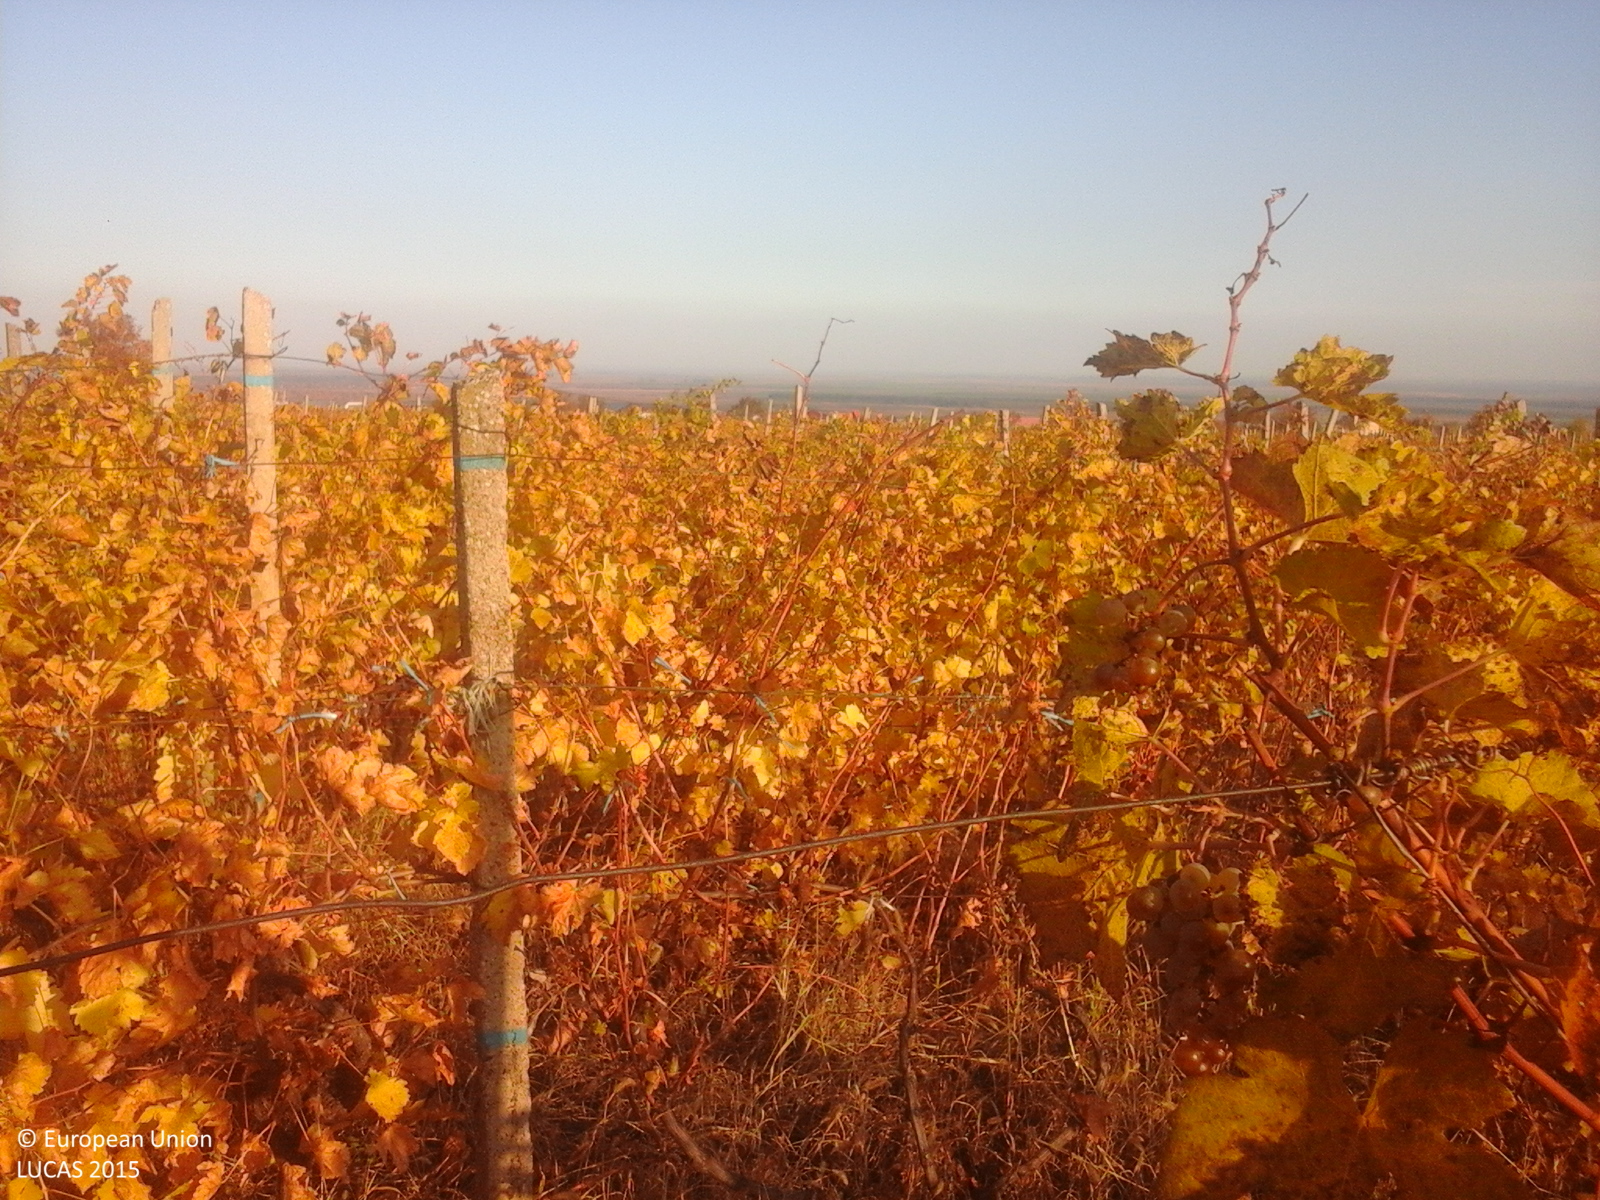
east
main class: Cropland
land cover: Vineyards
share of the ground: > 75 %
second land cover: Other bare soil
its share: > 75 %
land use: Agriculture (excluding fallow land and kitchen gardens)
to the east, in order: Vineyards; Other bare soil; Grass margins; Tracks; Grass margins; Vineyards; Grass margins; Tracks; Grass margins; Vineyards; Grass margins; Tracks; Grass margins; Vineyards
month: October
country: RO
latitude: 45.4857
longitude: 27.0415
